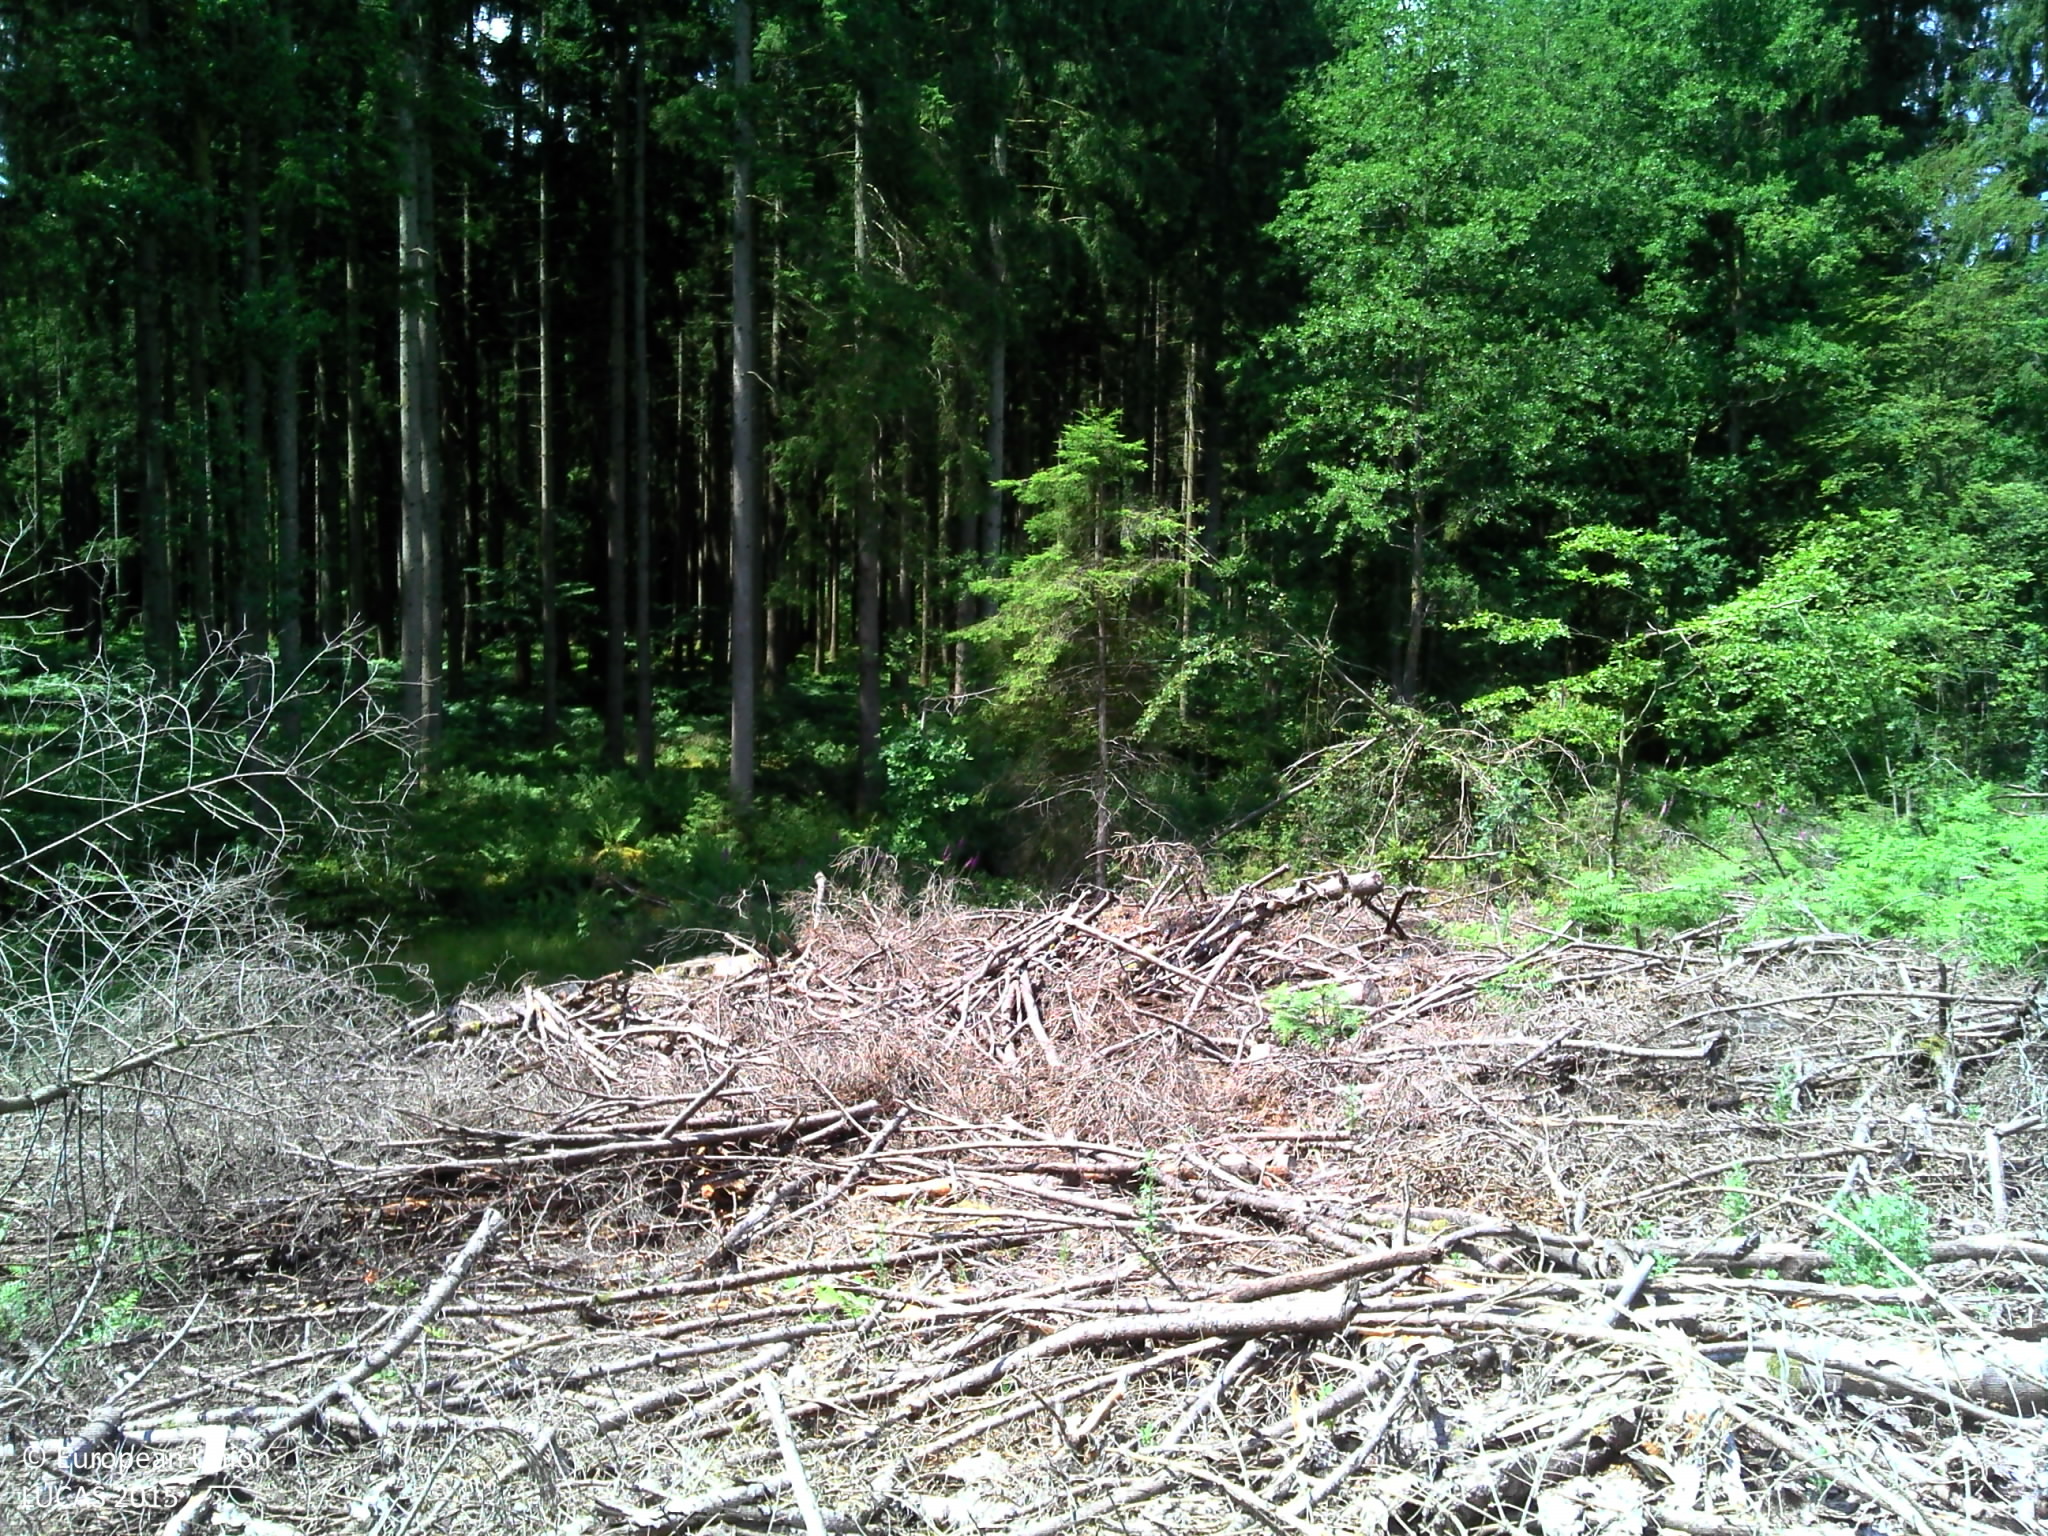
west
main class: Grassland
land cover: Spontaneously vegetated surfaces
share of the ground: > 75 %
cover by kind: herbaceous plants 60 %, unconsolidated bare surface 40 %
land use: Forestry
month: July
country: BE
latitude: 49.8704
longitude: 5.2812
